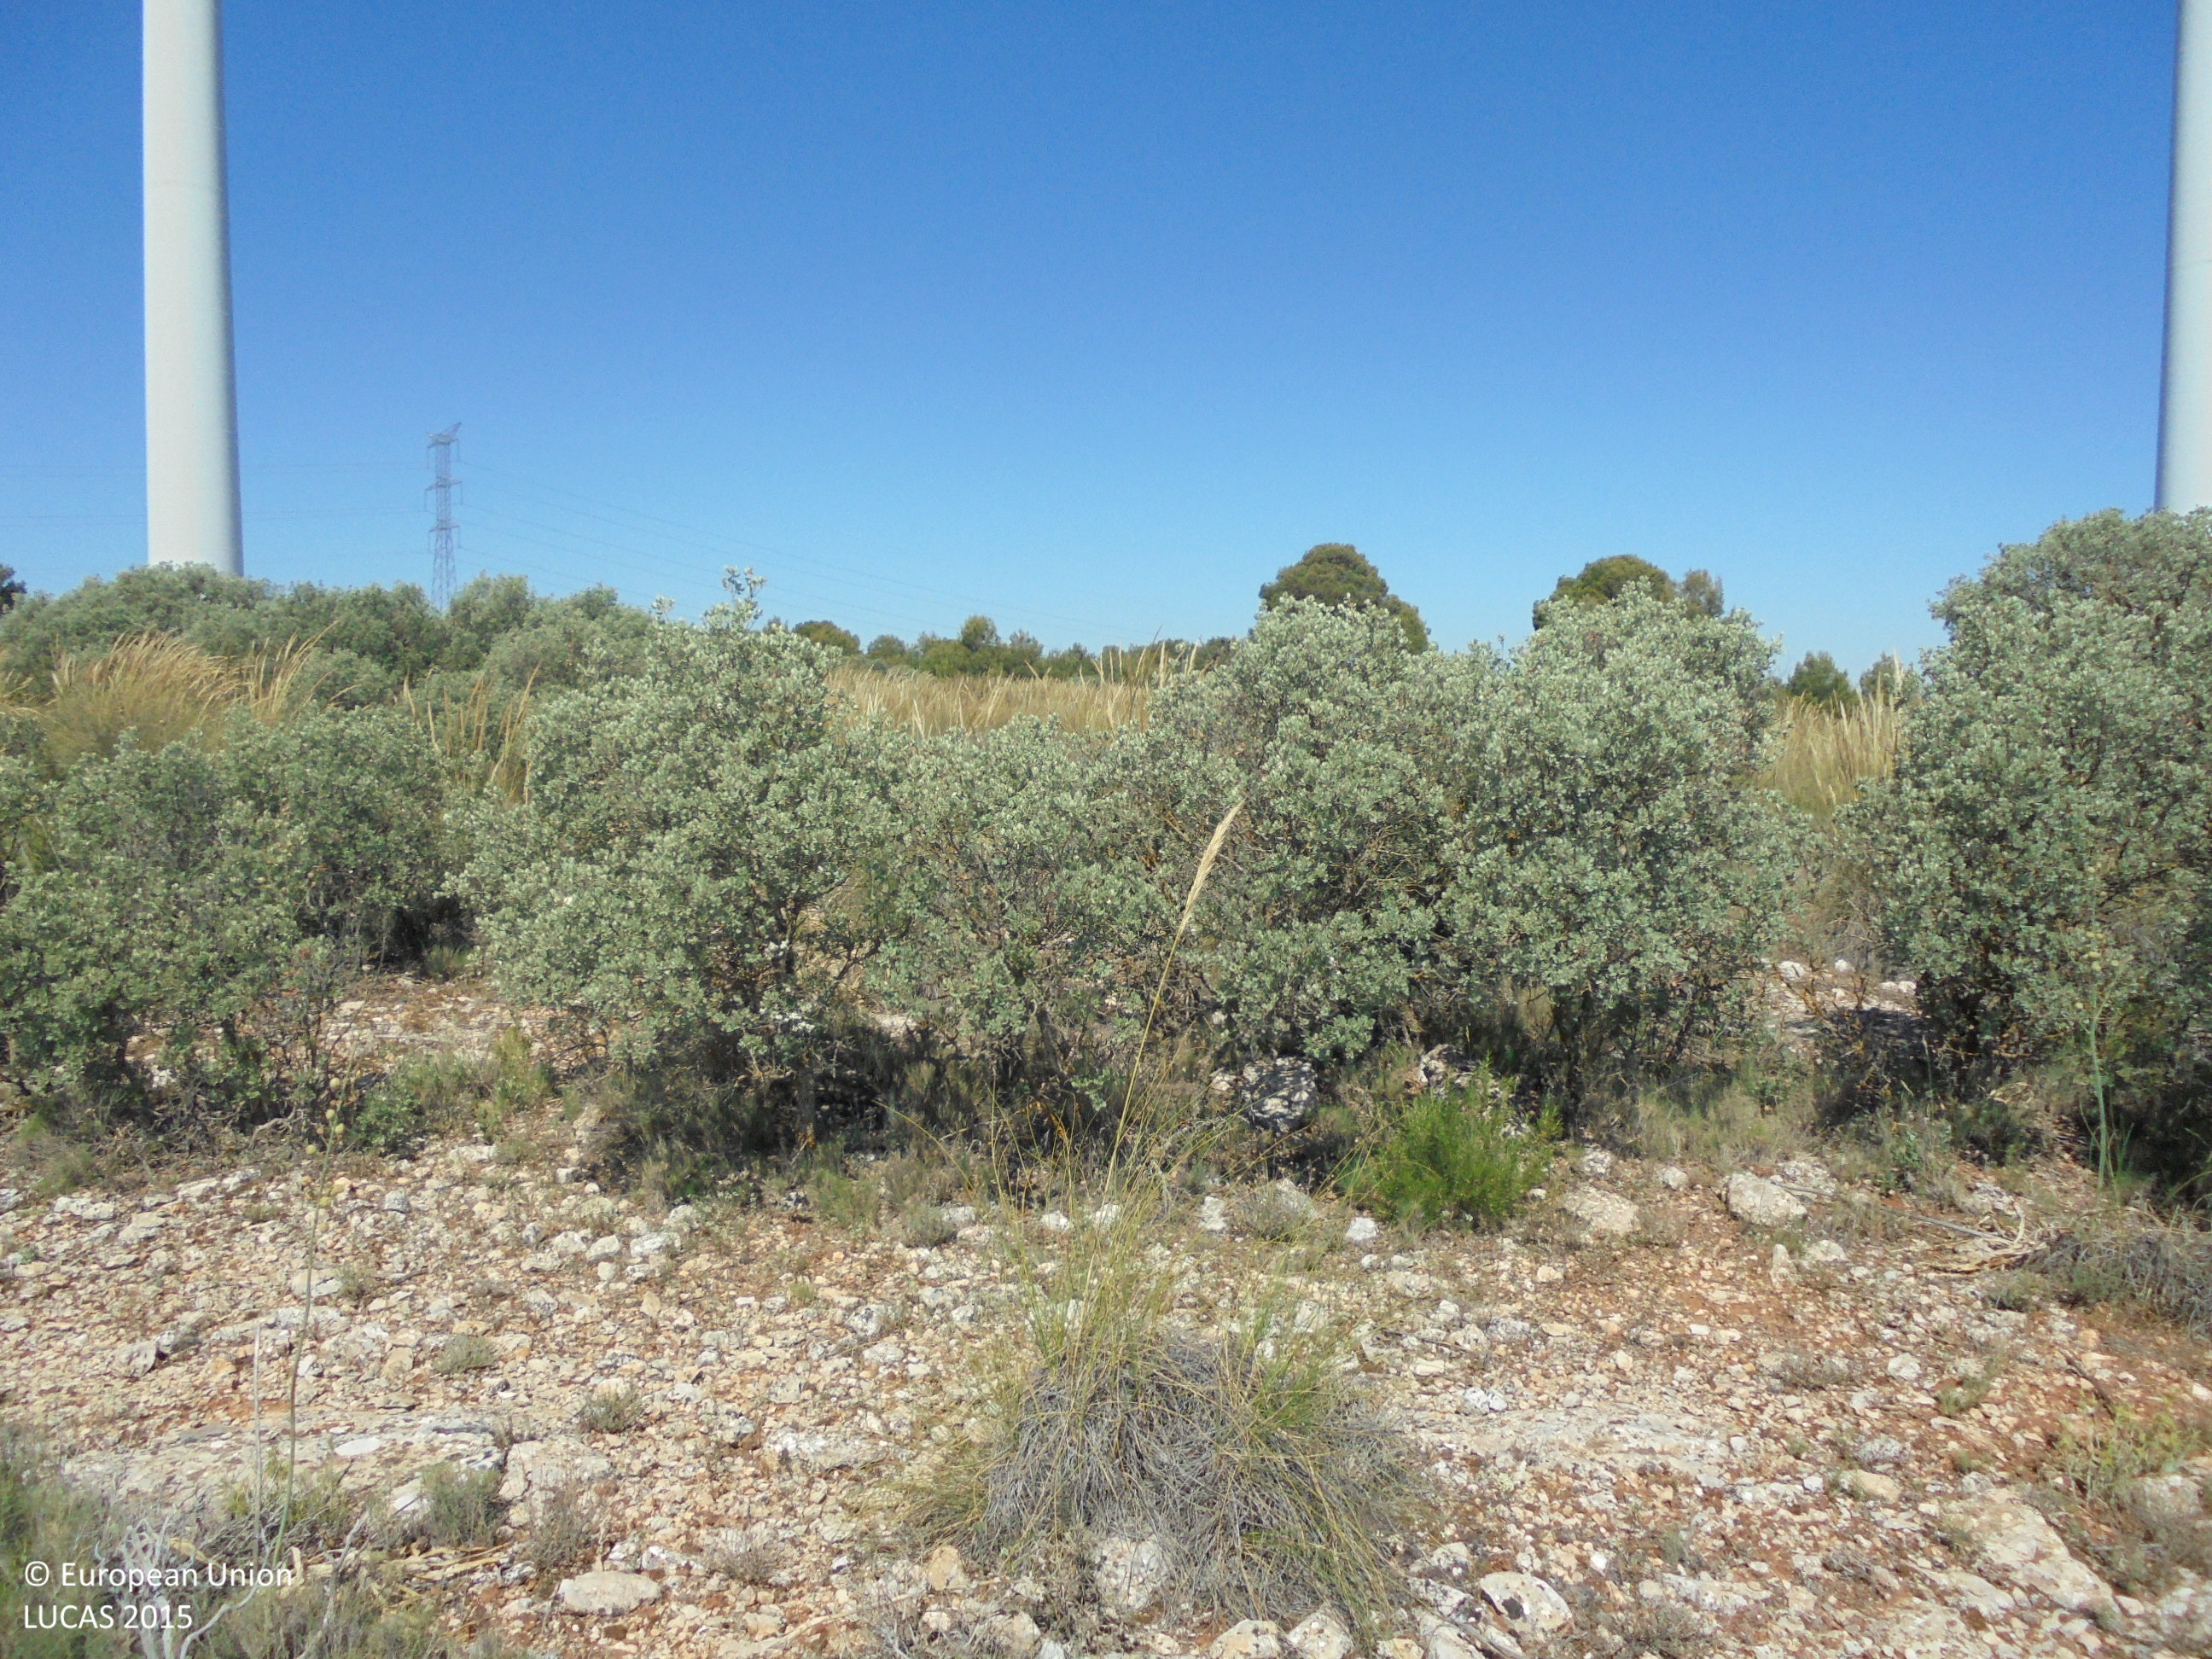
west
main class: Shrubland
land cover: Shrubland without tree cover
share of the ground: 50 - 75 %
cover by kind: shrubs 65 %, unconsolidated bare surface 25 %, consolidated bare surface 10 %
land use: Semi-natural and natural areas not in use
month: June
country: ES
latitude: 38.8378
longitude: -1.6674
